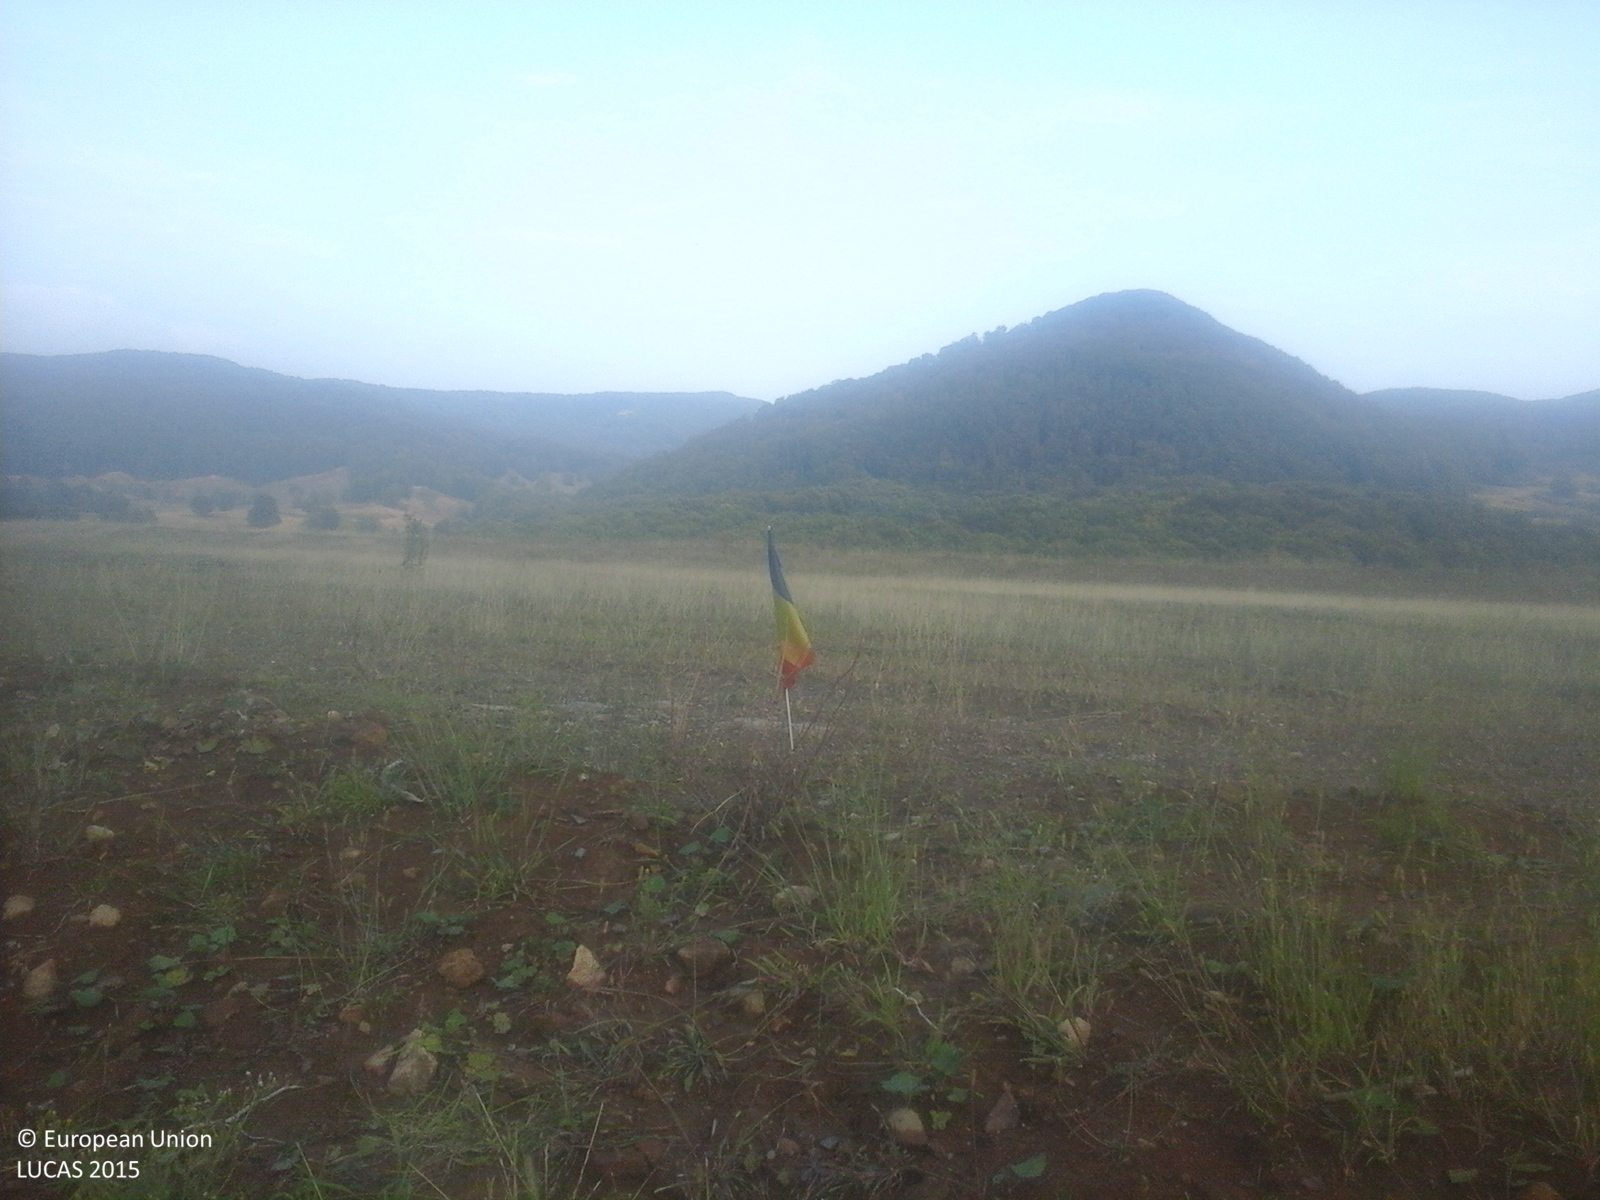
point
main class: Grassland
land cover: Grassland without tree/shrub cover
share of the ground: 50 - 75 %
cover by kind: herbaceous plants 100 %
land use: Agriculture (excluding fallow land and kitchen gardens)
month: September
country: RO
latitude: 47.6243
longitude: 23.7992
